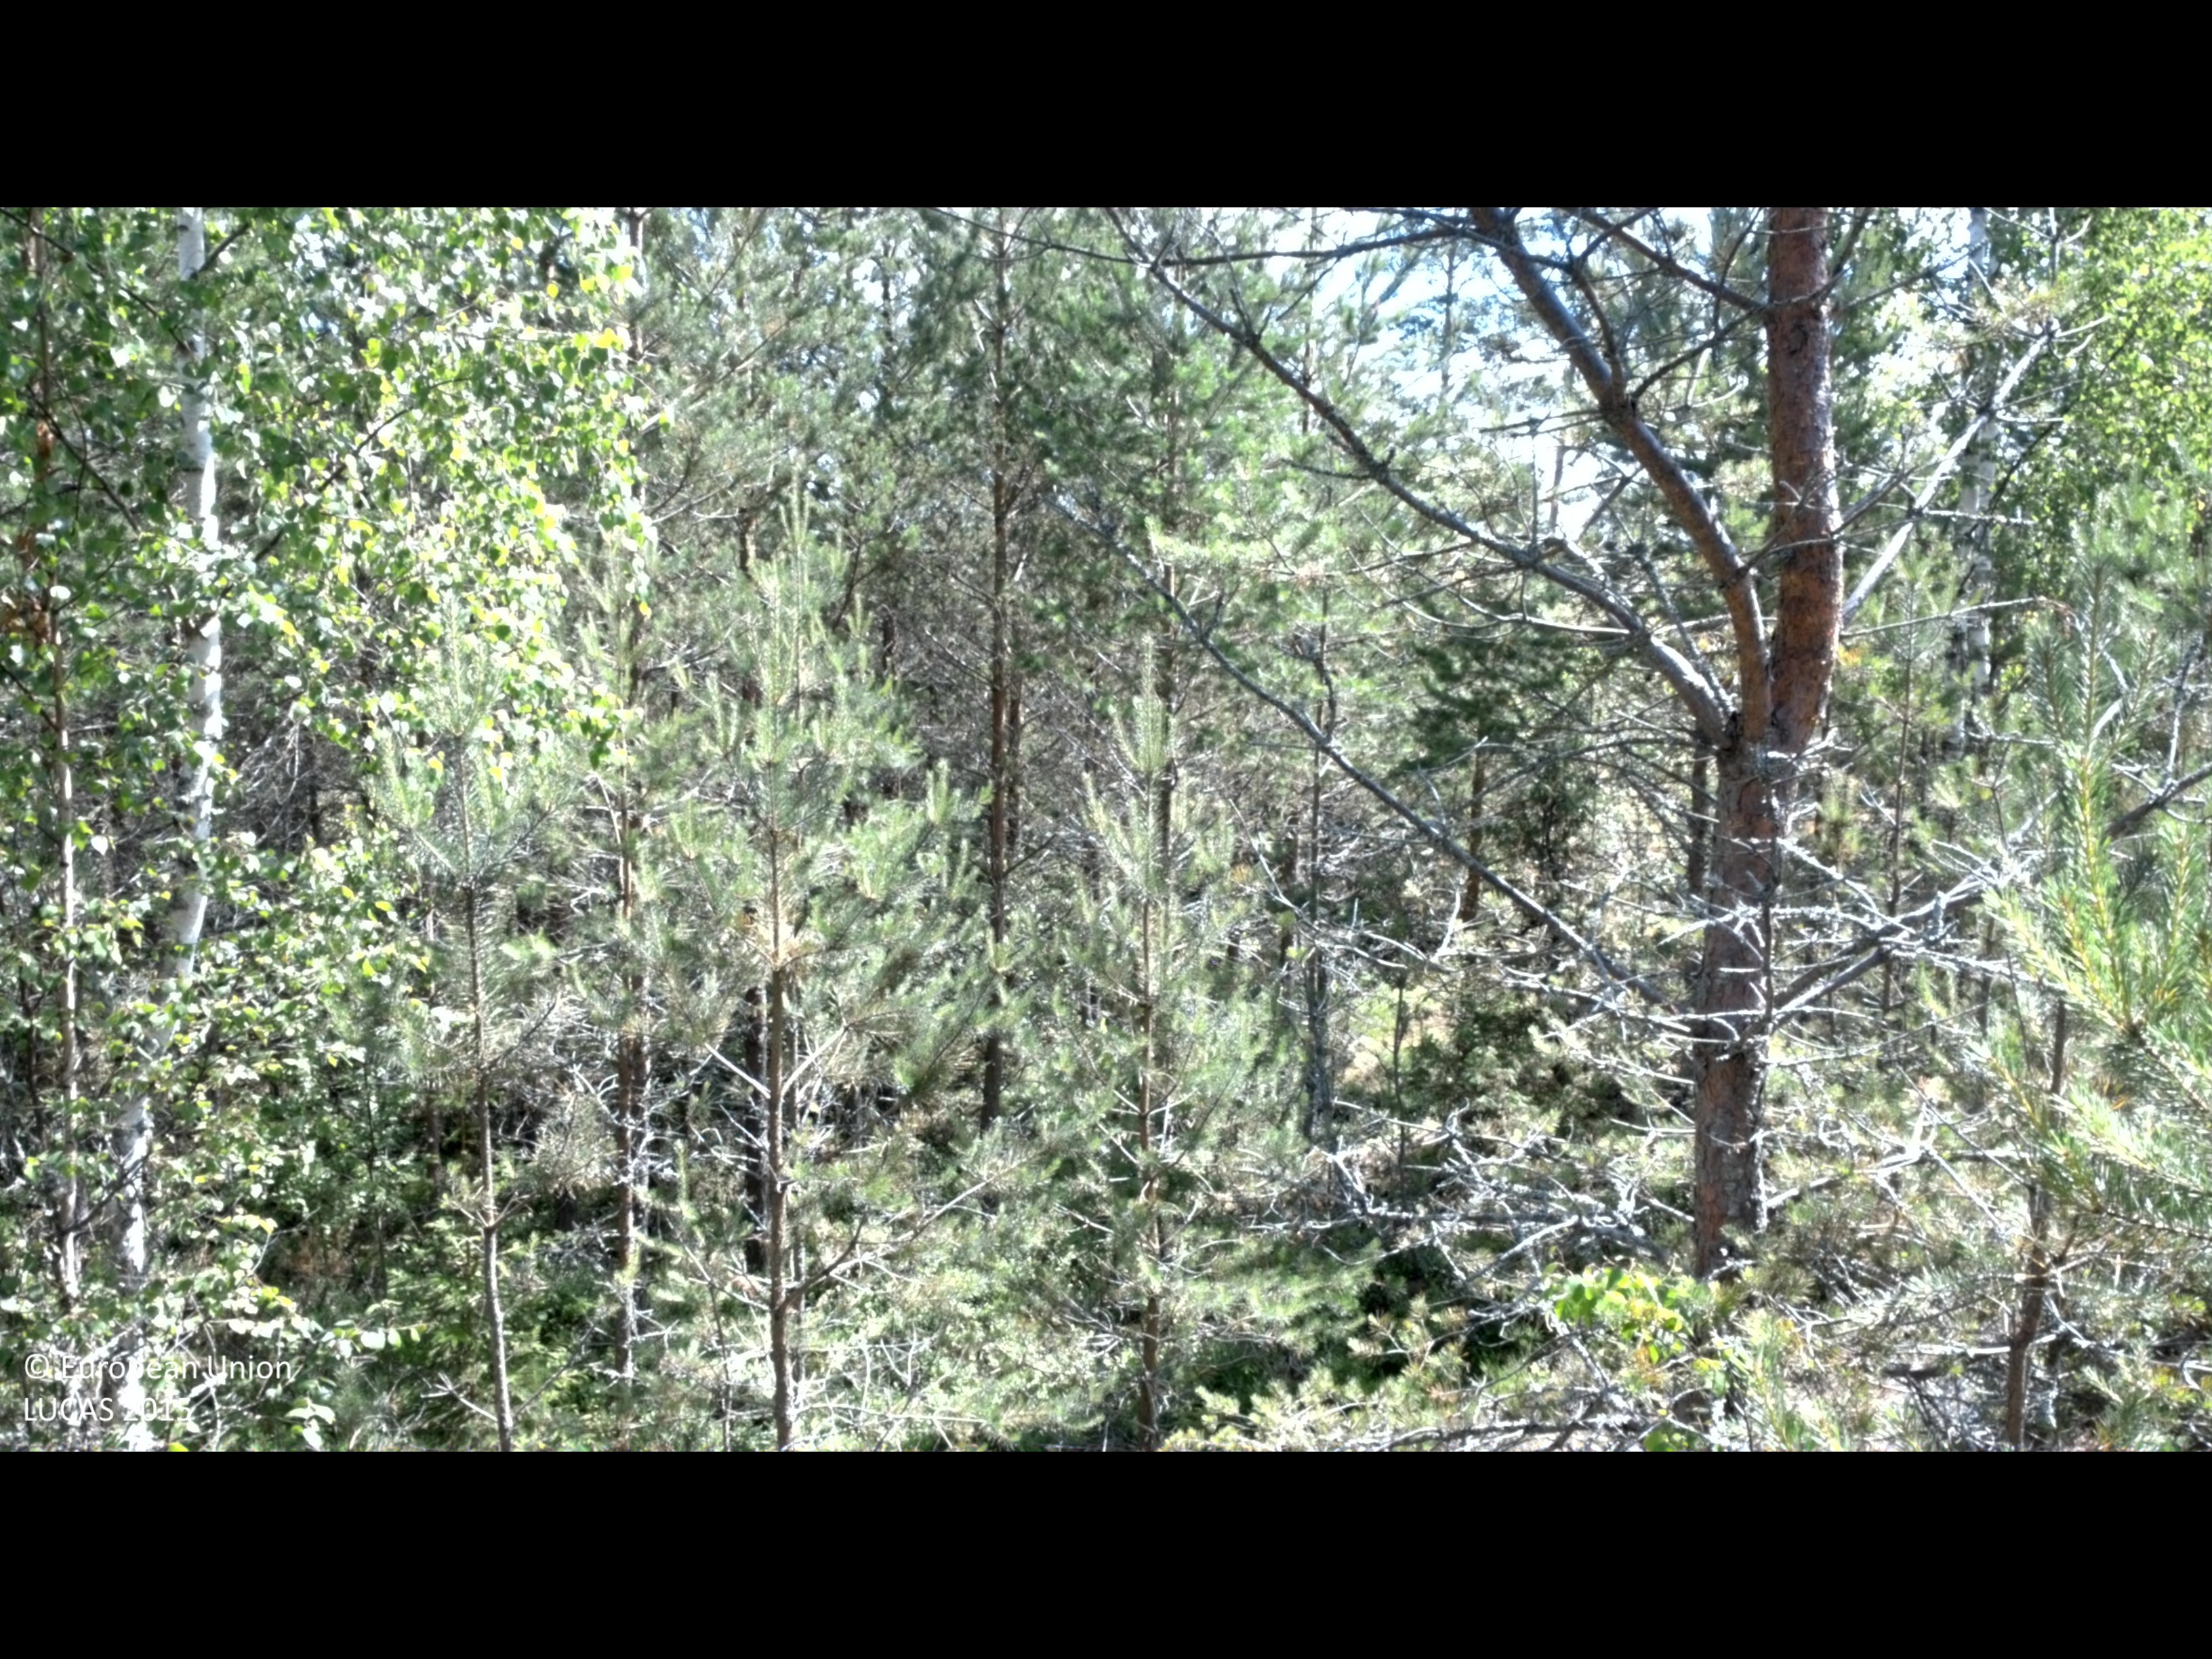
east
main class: Woodland
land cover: Pine dominated mixed woodland
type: boreal forest
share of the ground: 50 - 75 %
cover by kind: coniferous forest trees 45 %, shrubs 20 %, lichens and mosses 20 %, broadleaved forest trees 15 %
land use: Forestry
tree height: > 5 m
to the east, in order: Pine dominated mixed woodland; Pine dominated coniferous woodland; Other mixed woodland; Paved roads, cycling and walking lanes; Grassland without tree/shrub cover; Broadleaved woodland; Ditches and canals; Abandoned hedges; Grassland without tree/shrub cover; Fences; Broadleaved woodland
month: June
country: SE
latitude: 58.2071
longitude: 16.1054
